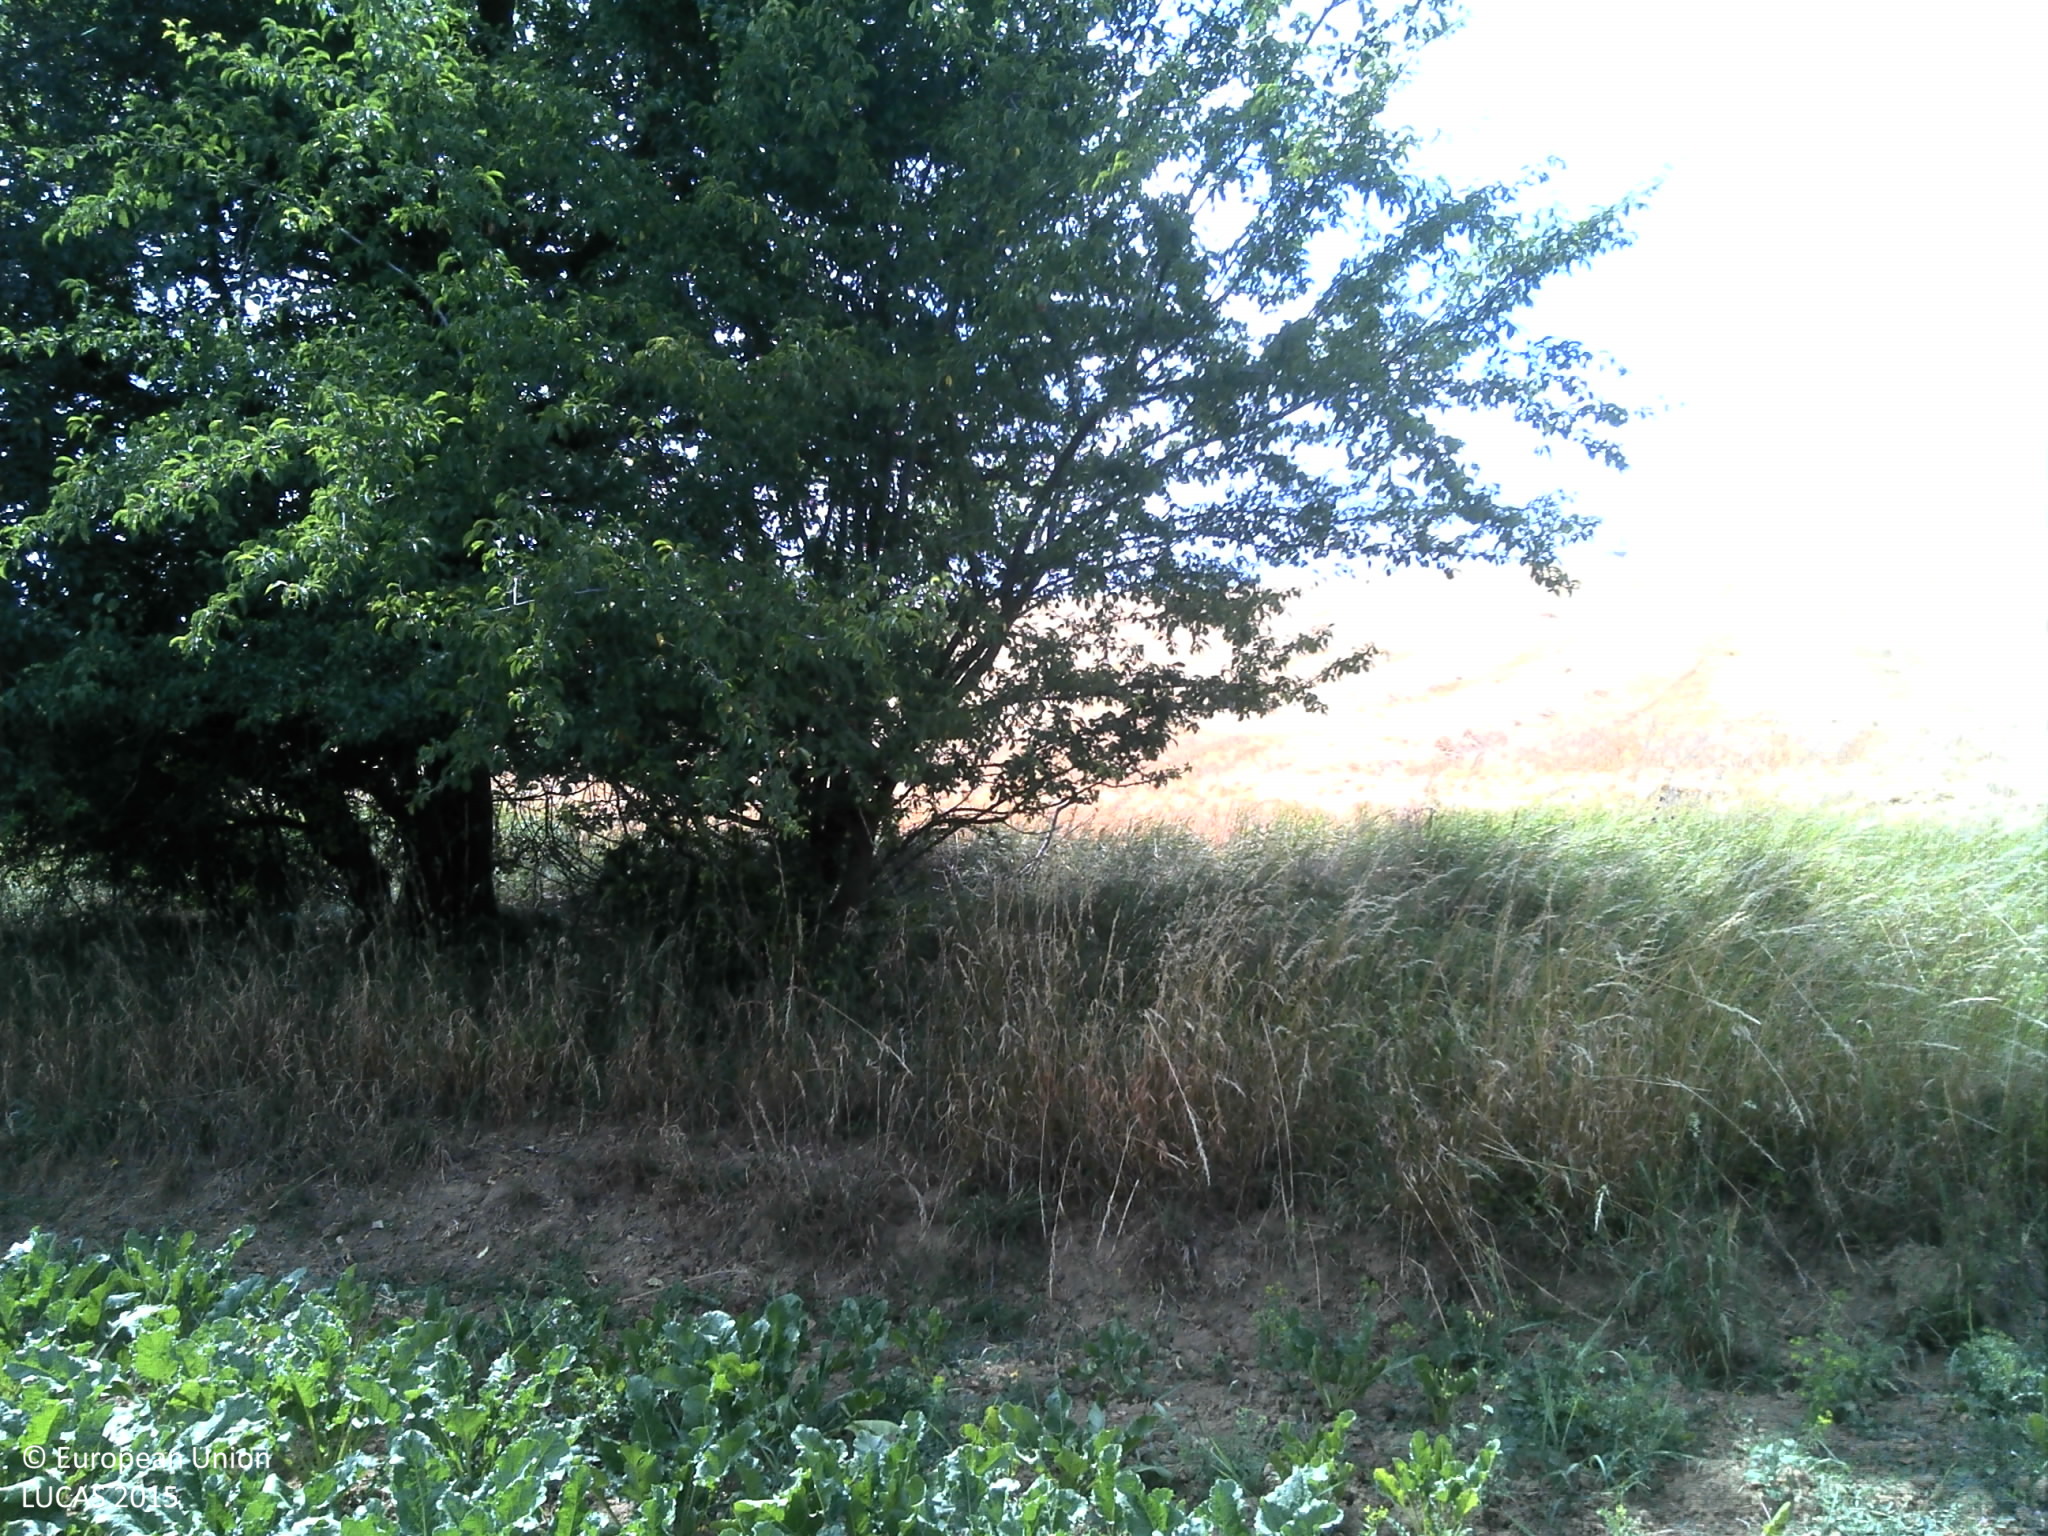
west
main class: Cropland
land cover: Sugar beet
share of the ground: > 75 %
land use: Agriculture (excluding fallow land and kitchen gardens)
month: July
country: FR
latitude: 49.1670
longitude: 7.4907
